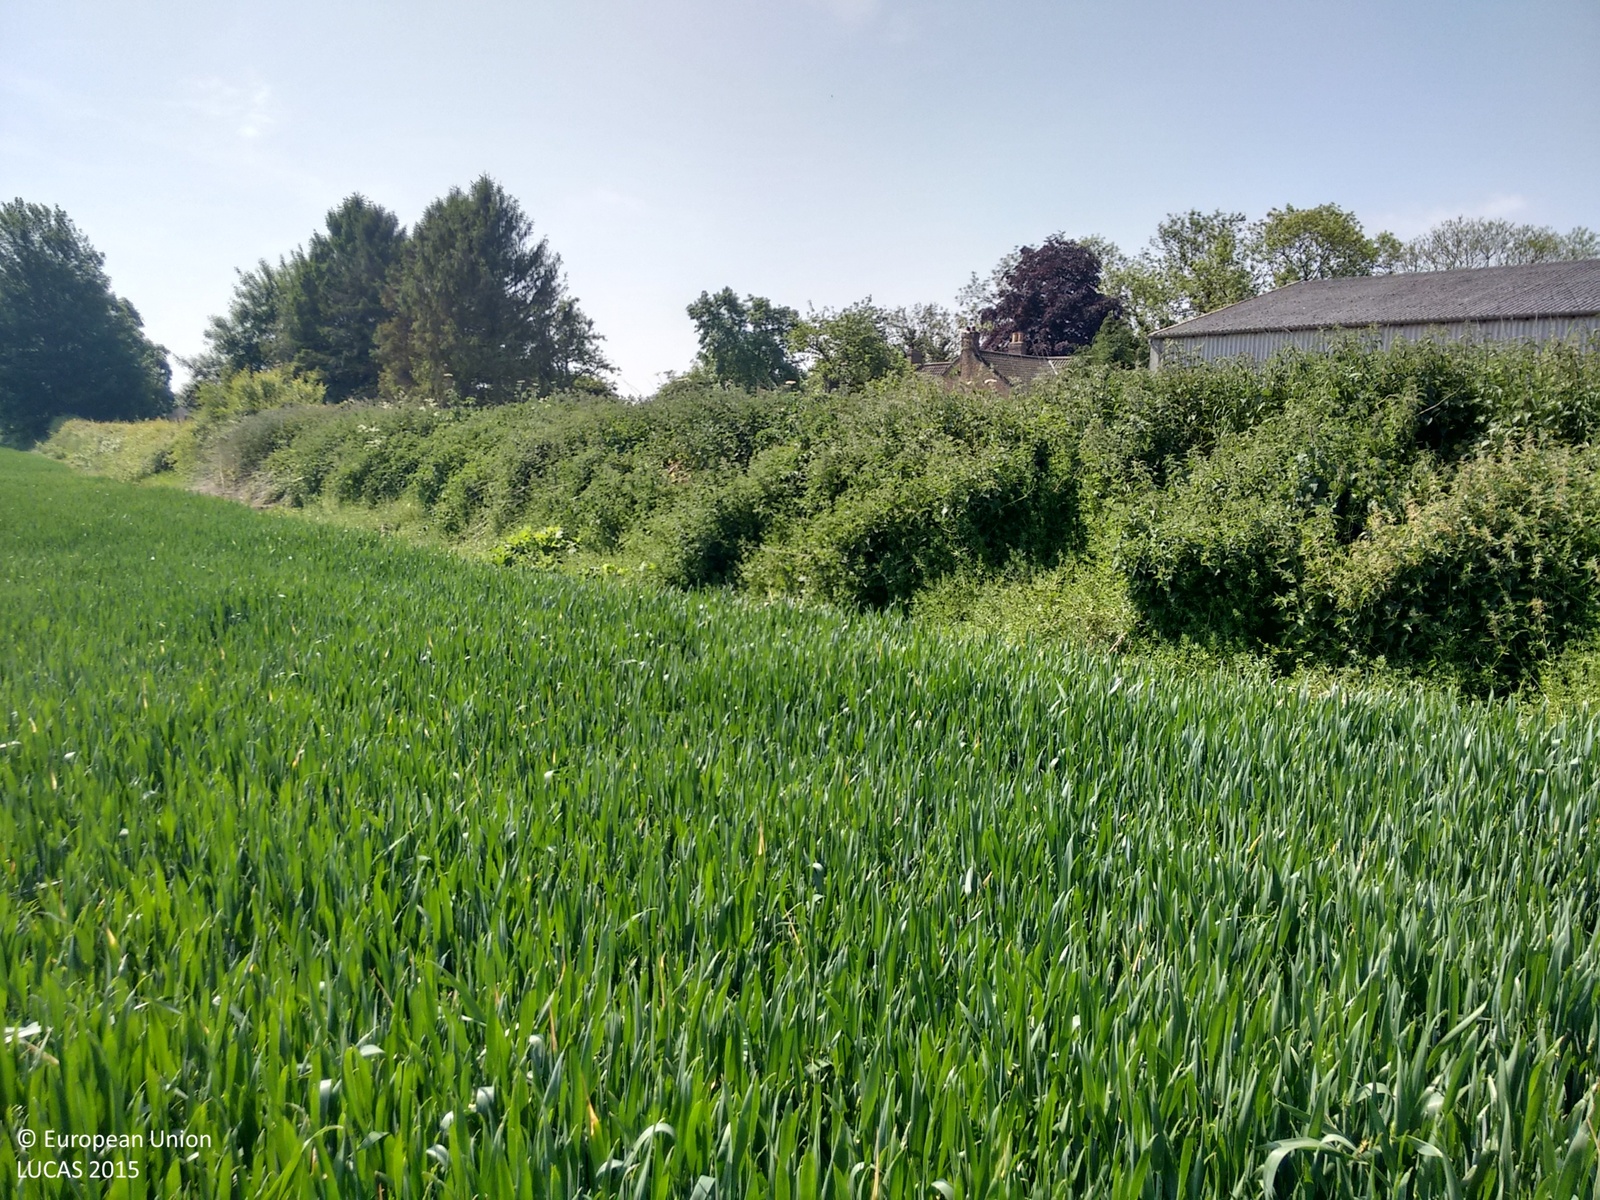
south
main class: Cropland
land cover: Common wheat
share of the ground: > 75 %
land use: Agriculture (excluding fallow land and kitchen gardens)
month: June
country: GB
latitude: 53.9328
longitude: -1.2099
